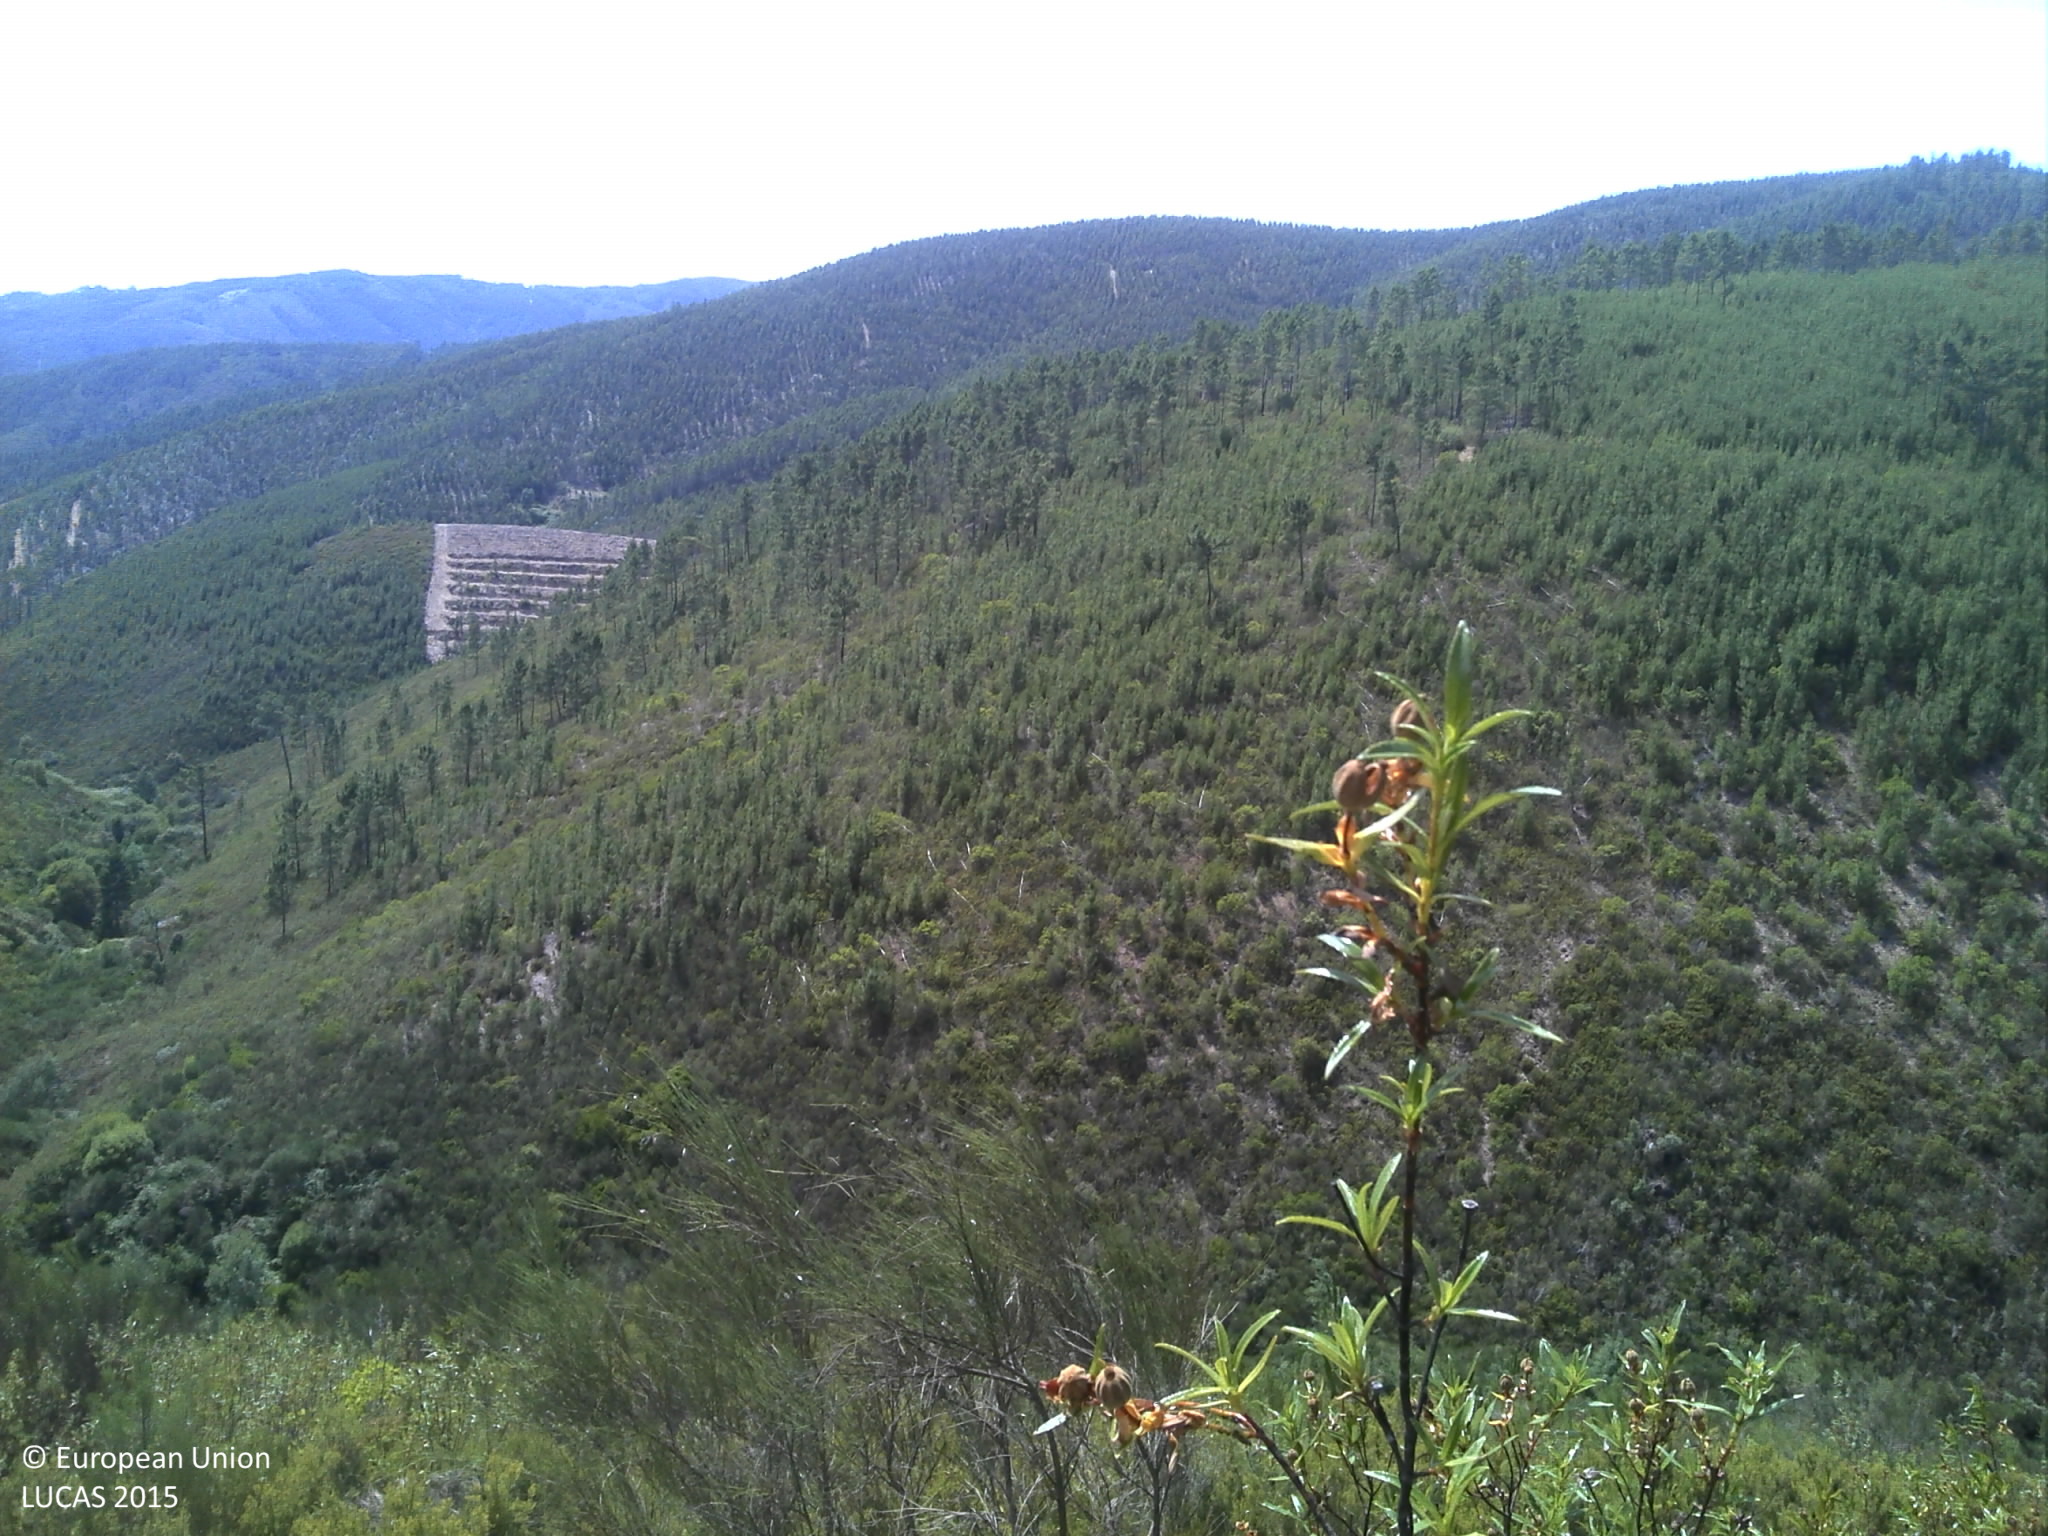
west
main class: Shrubland
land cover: Shrubland with sparse tree cover
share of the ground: 50 - 75 %
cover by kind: shrubs 75 %, unconsolidated bare surface 20 %, coniferous forest trees 5 %
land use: Semi-natural and natural areas not in use
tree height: < 5 m
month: July
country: PT
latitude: 40.0347
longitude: -7.8668
